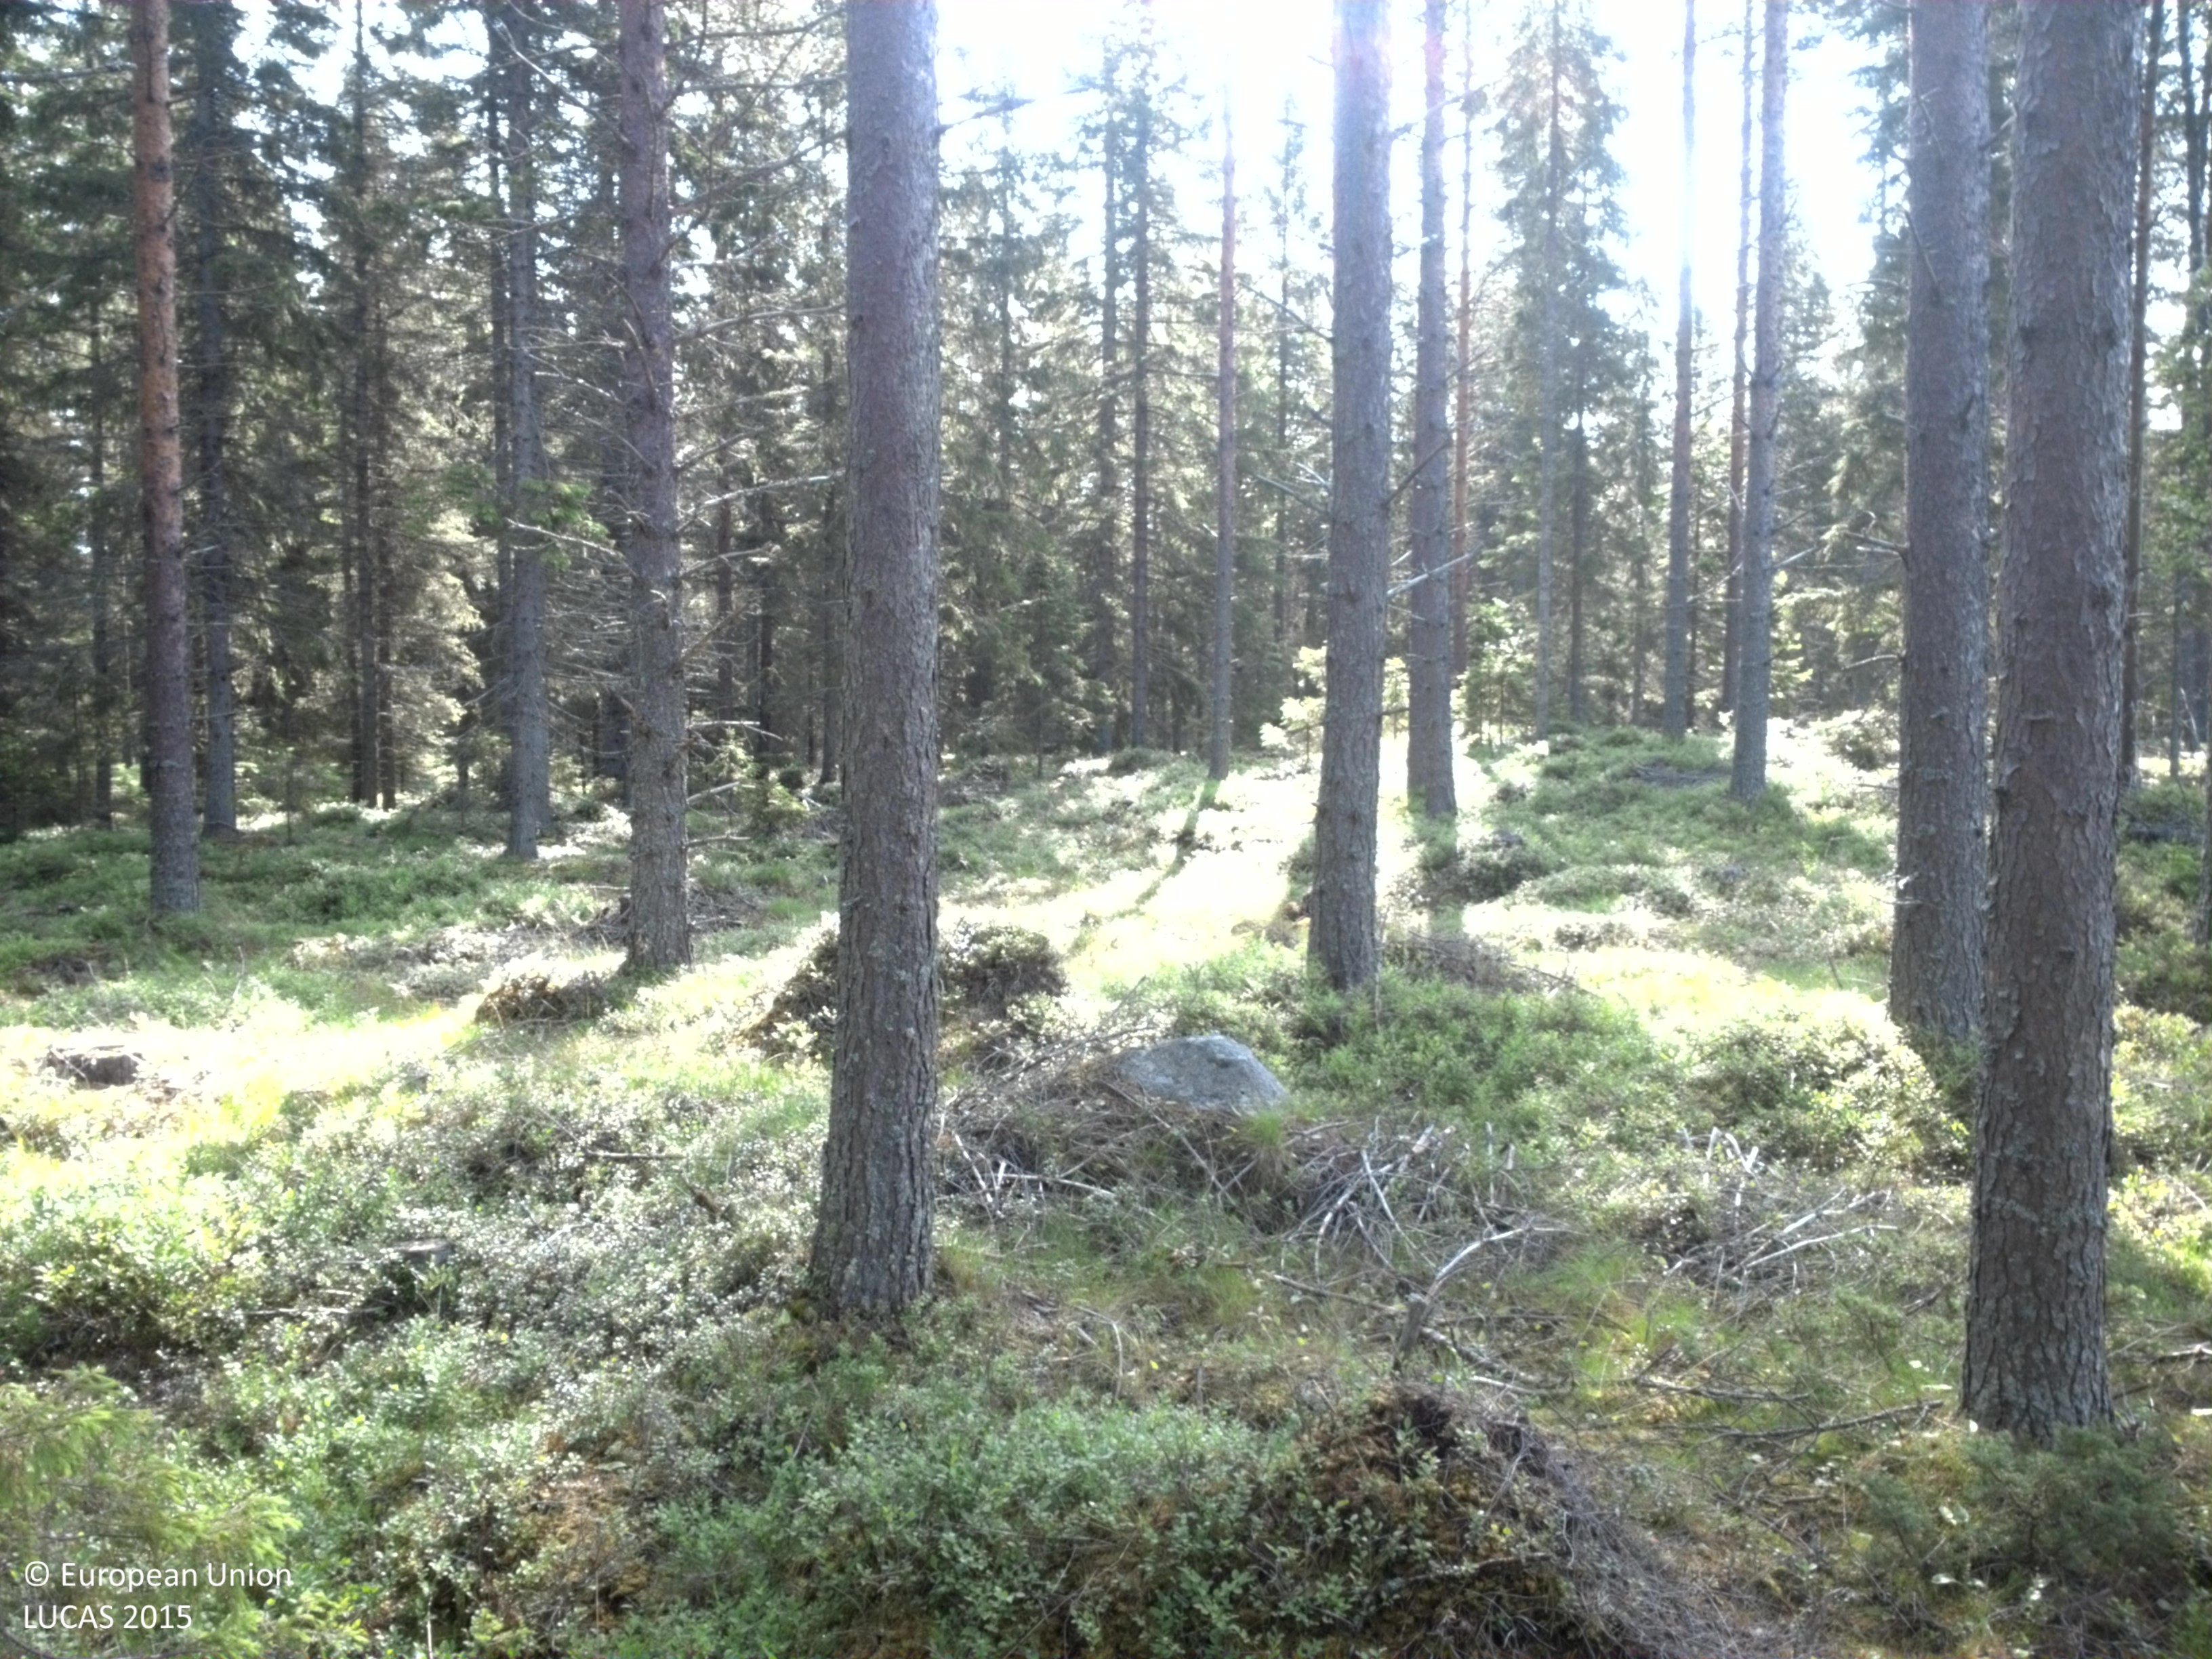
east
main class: Woodland
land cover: Pine dominated coniferous woodland
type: boreal forest
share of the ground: 50 - 75 %
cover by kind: coniferous forest trees 65 %, shrubs 35 %
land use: Forestry
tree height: > 5 m
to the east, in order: Pine dominated coniferous woodland; Spruce dominated coniferous woodland; Spruce dominated mixed woodland
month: July
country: SE
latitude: 64.4499
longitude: 21.5611
